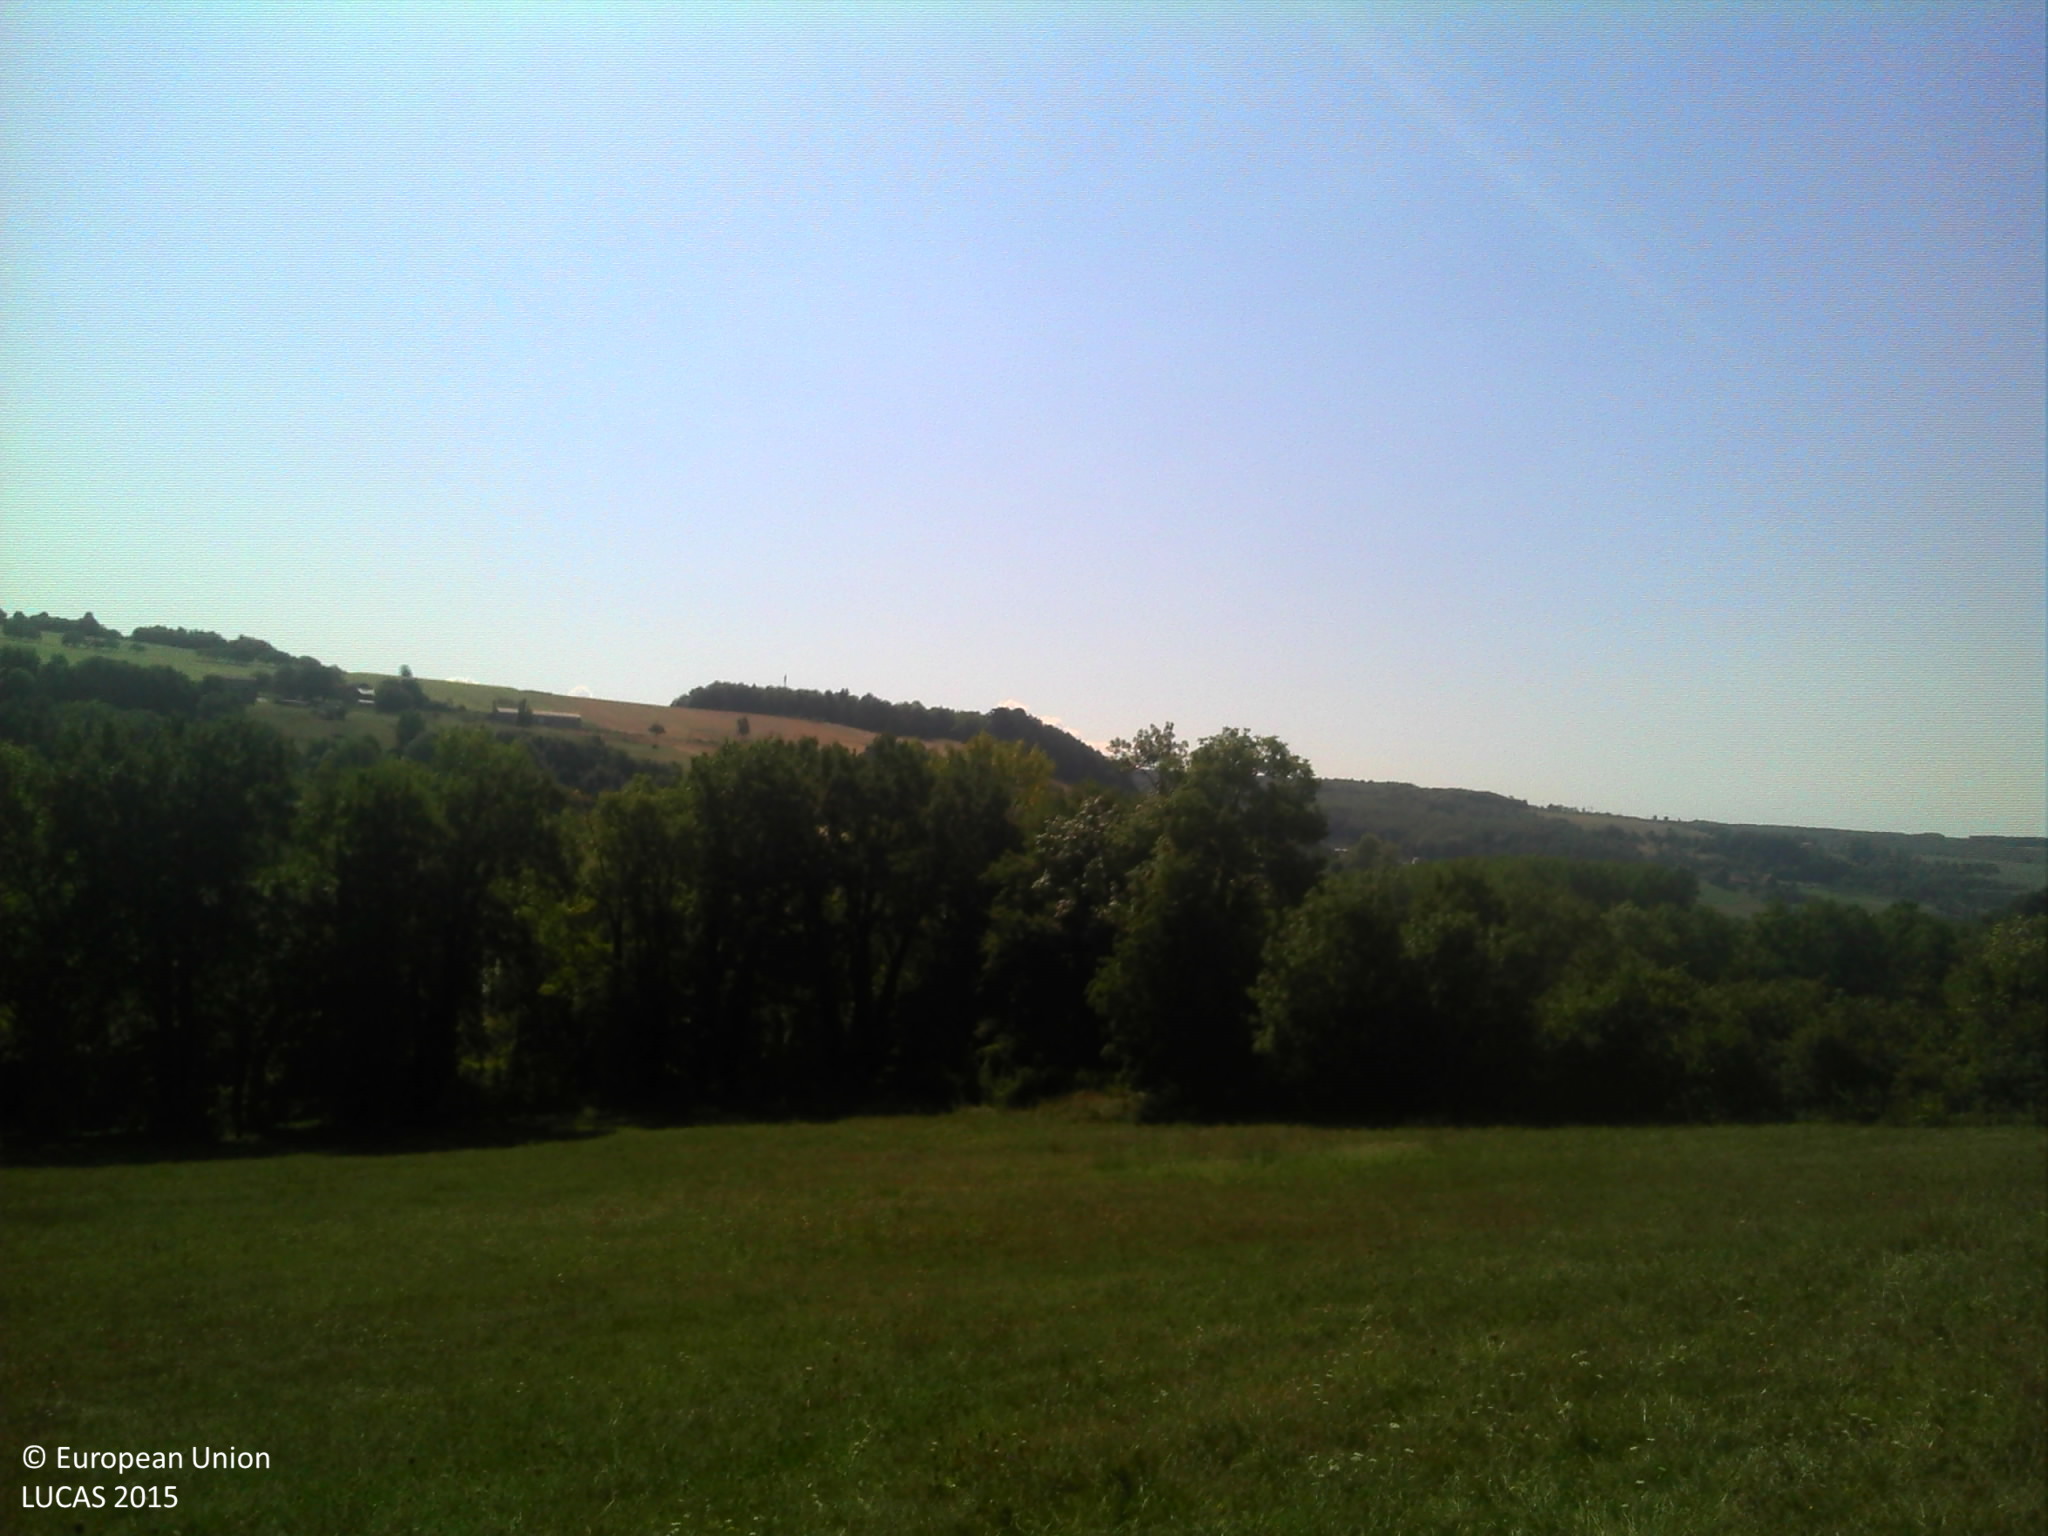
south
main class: Grassland
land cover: Grassland without tree/shrub cover
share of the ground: > 75 %
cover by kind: herbaceous plants 100 %
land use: Agriculture (excluding fallow land and kitchen gardens)
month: September
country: FR
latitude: 45.2114
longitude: 5.1285
